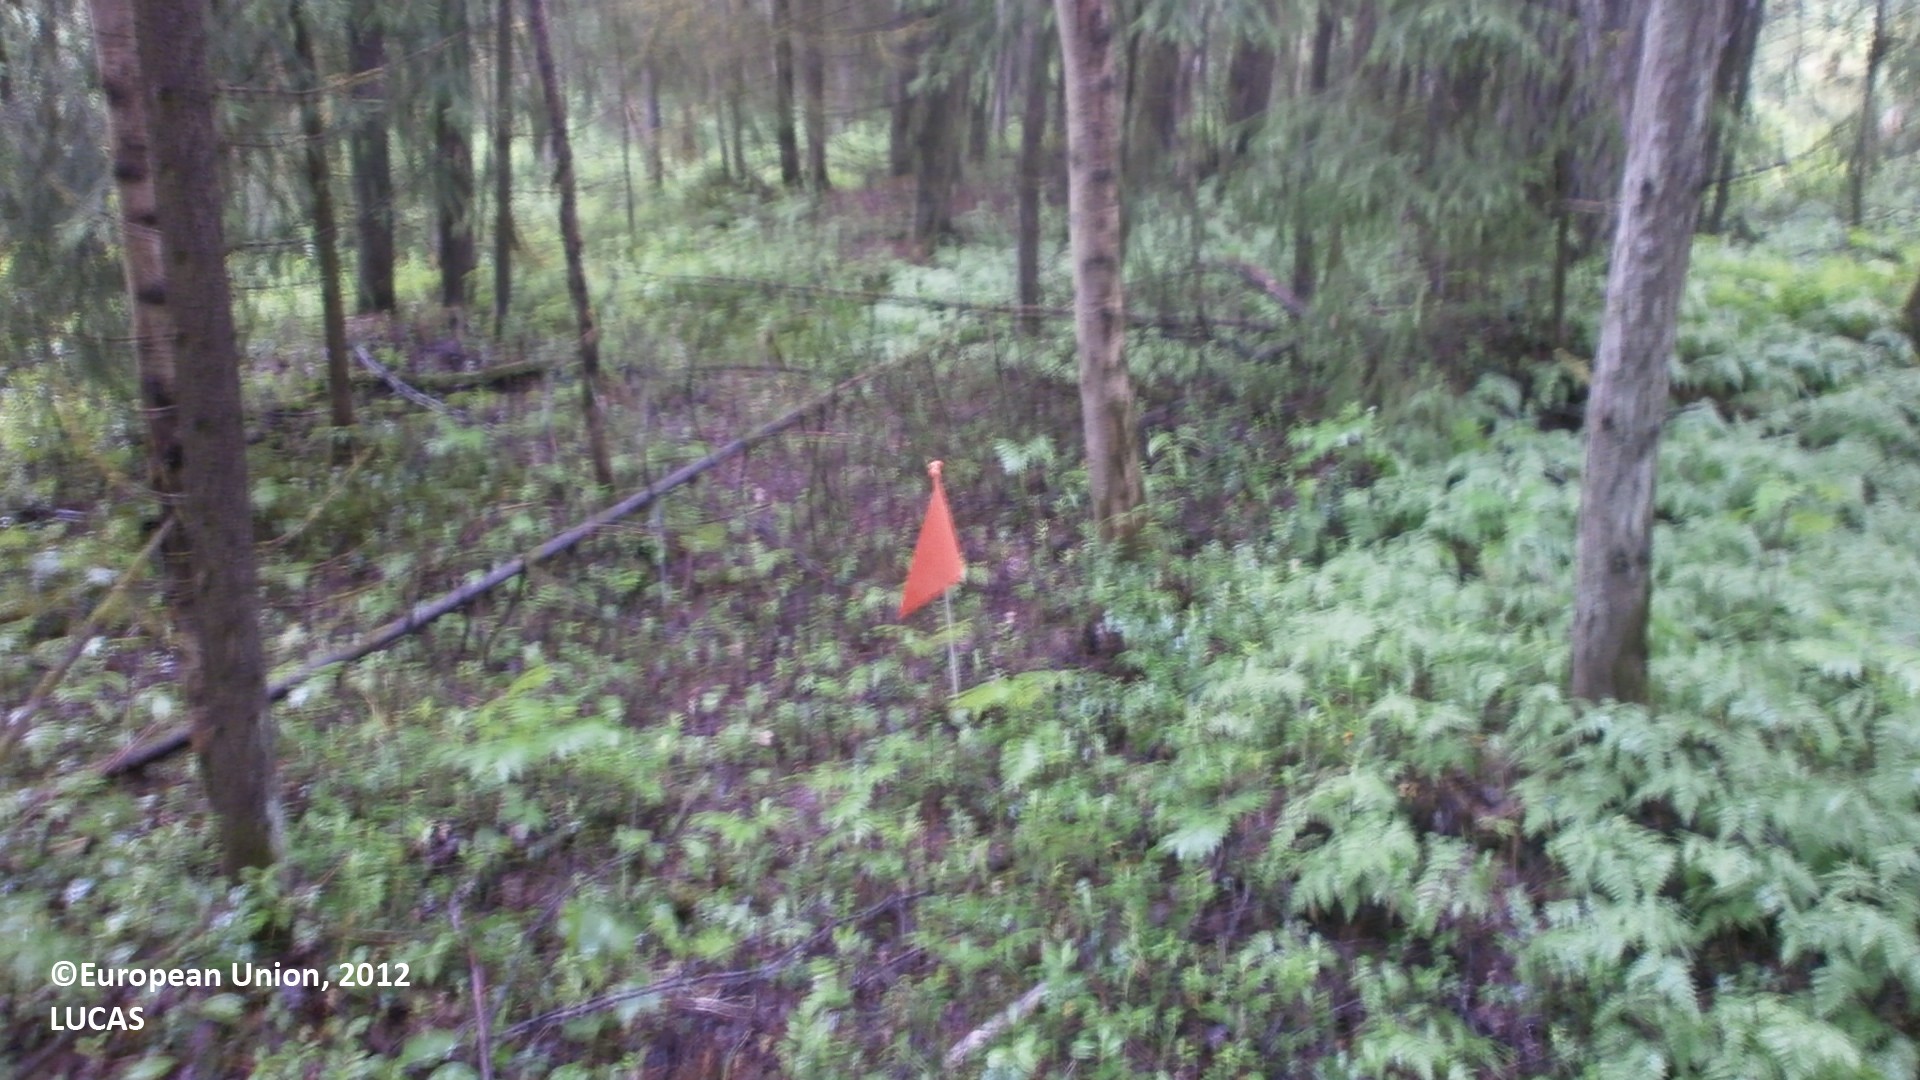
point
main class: Woodland
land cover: Spruce dominated mixed woodland
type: boreal forest
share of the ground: > 75 %
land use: Forestry
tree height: > 5 m
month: July
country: FI
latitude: 64.6537
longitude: 24.4495
